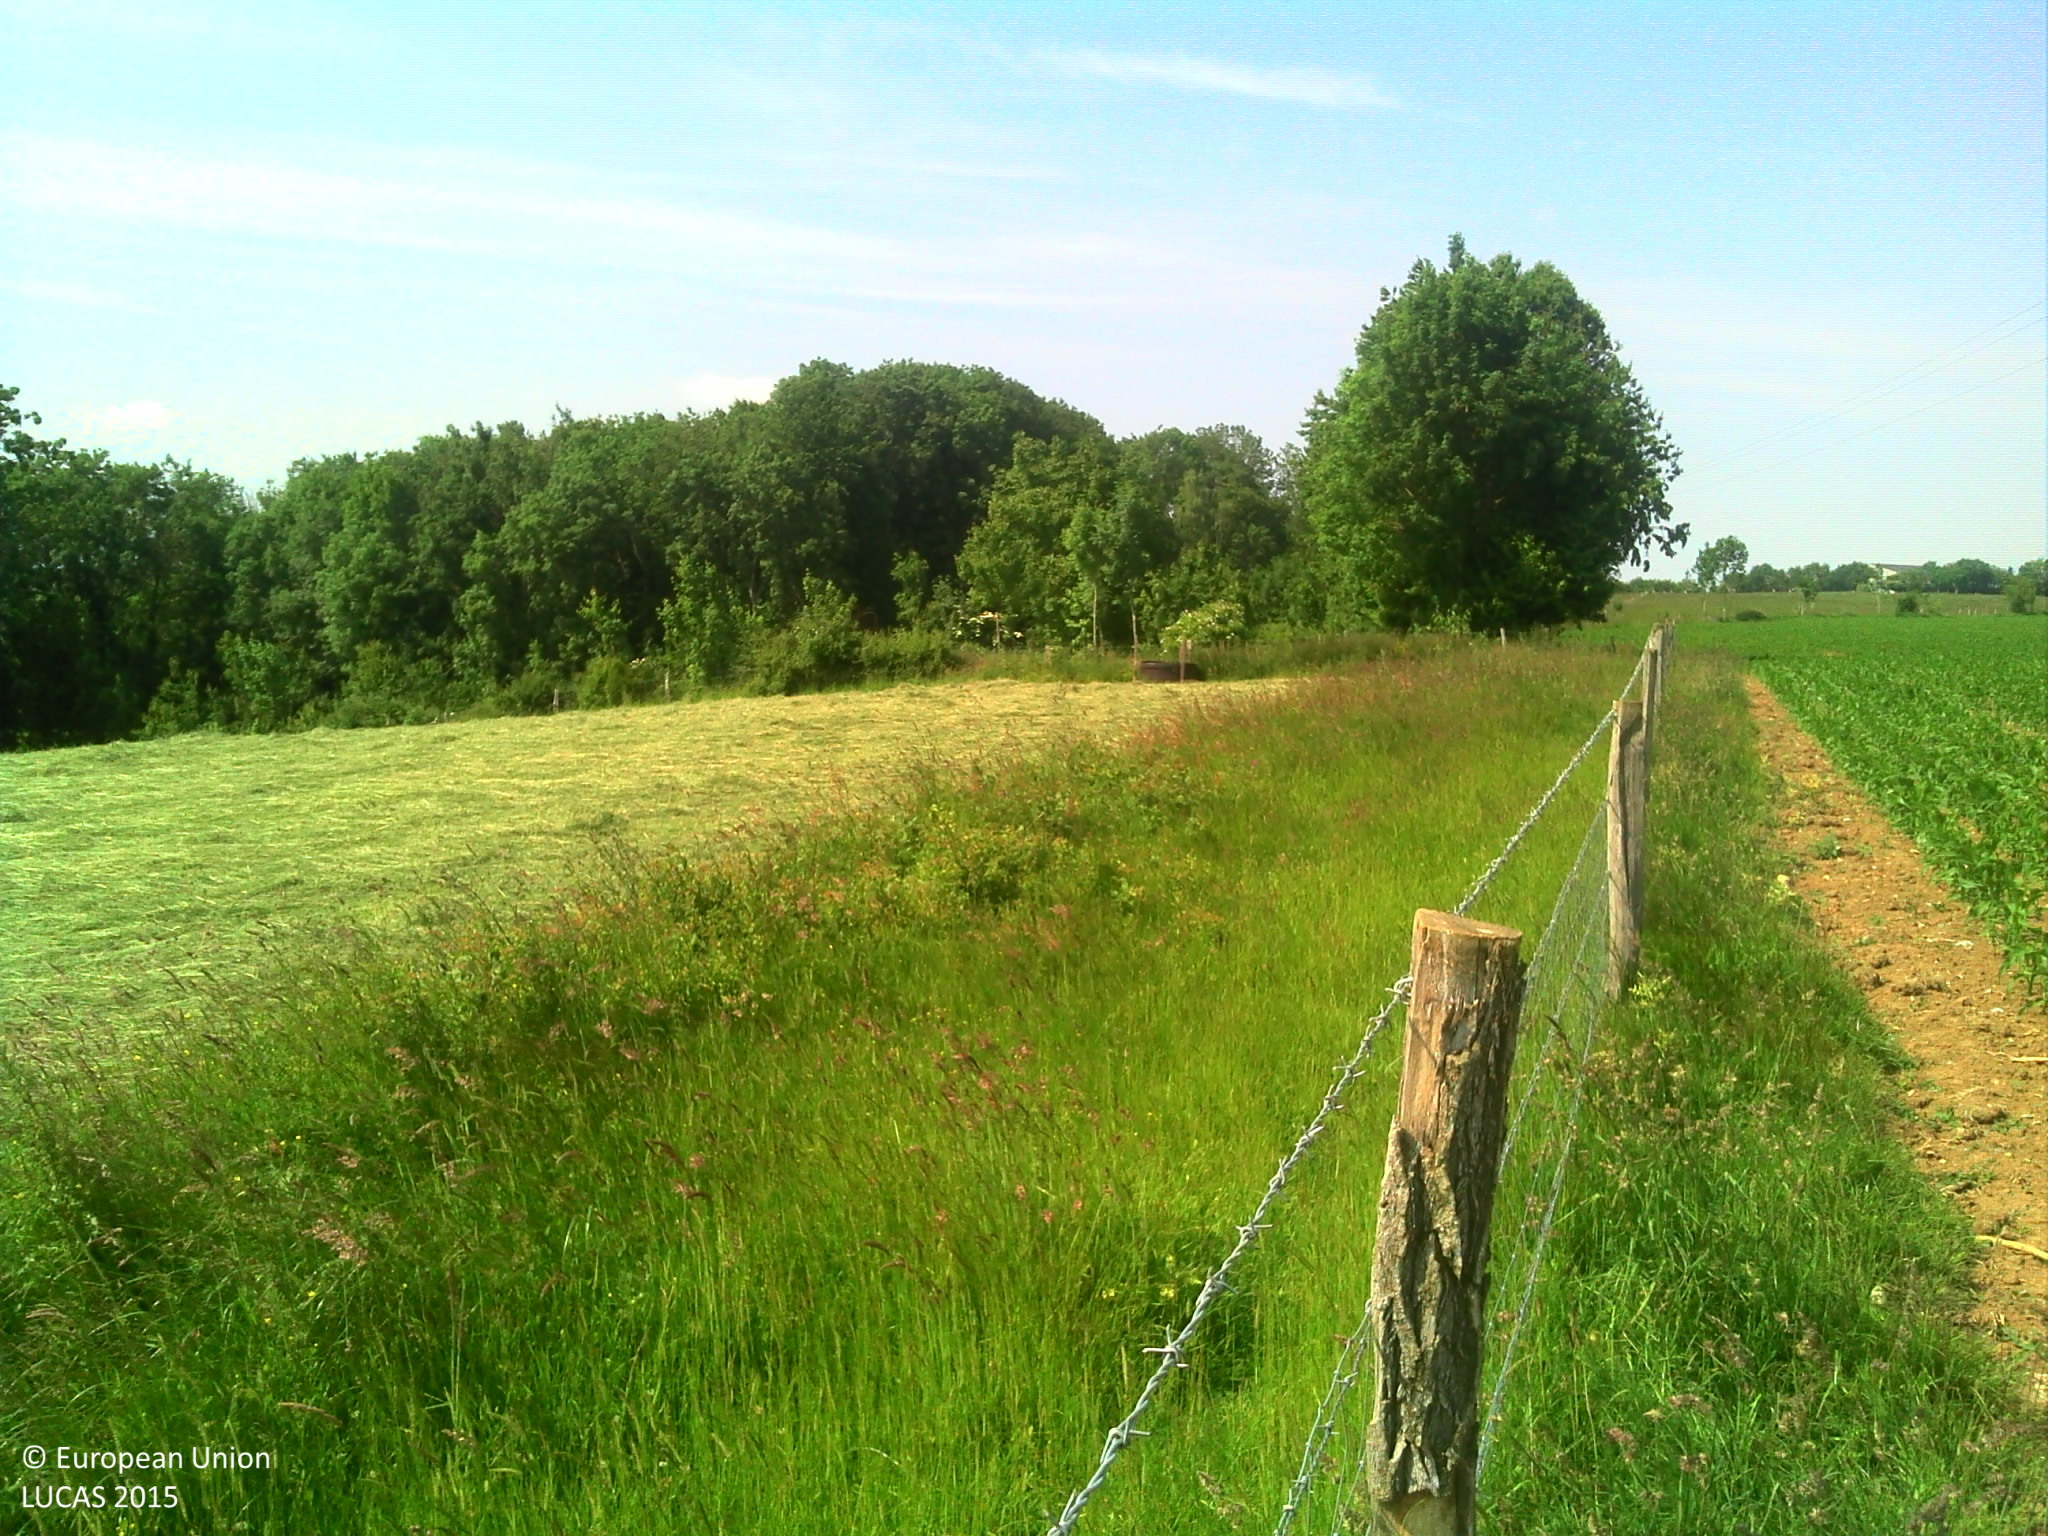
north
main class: Grassland
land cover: Grassland without tree/shrub cover
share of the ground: > 75 %
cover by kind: herbaceous plants 100 %
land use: Agriculture (excluding fallow land and kitchen gardens)
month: June
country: FR
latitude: 49.7443
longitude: 4.1248
